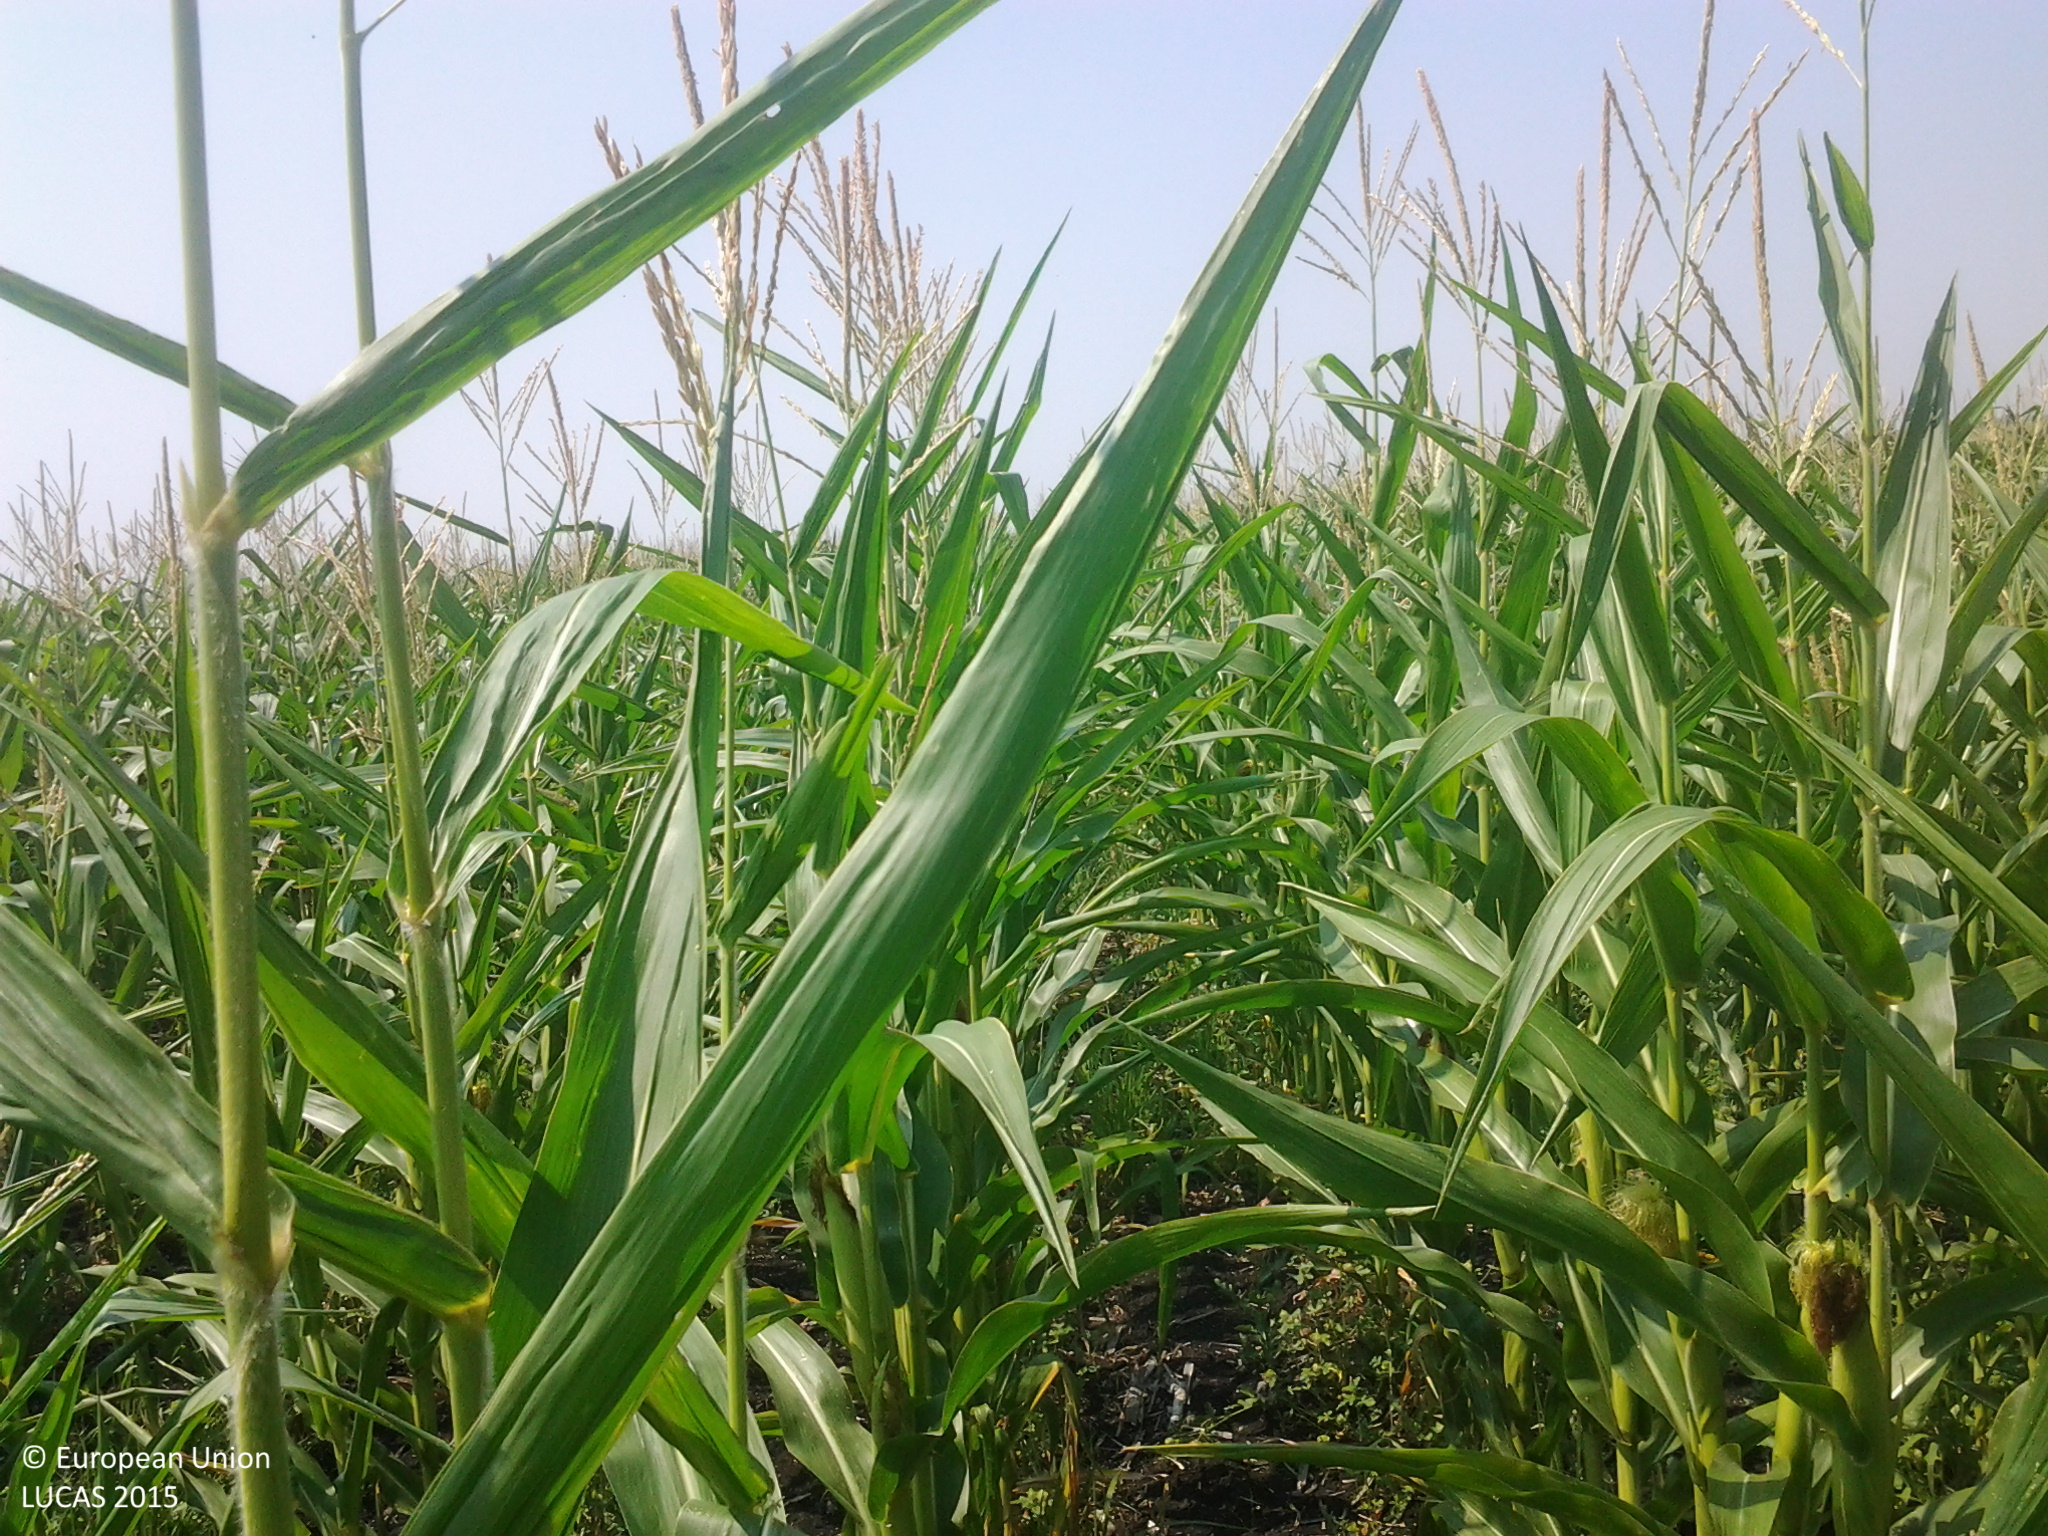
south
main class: Cropland
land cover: Maize
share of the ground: > 75 %
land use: Agriculture (excluding fallow land and kitchen gardens)
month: July
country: HU
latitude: 47.5507
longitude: 20.5694
